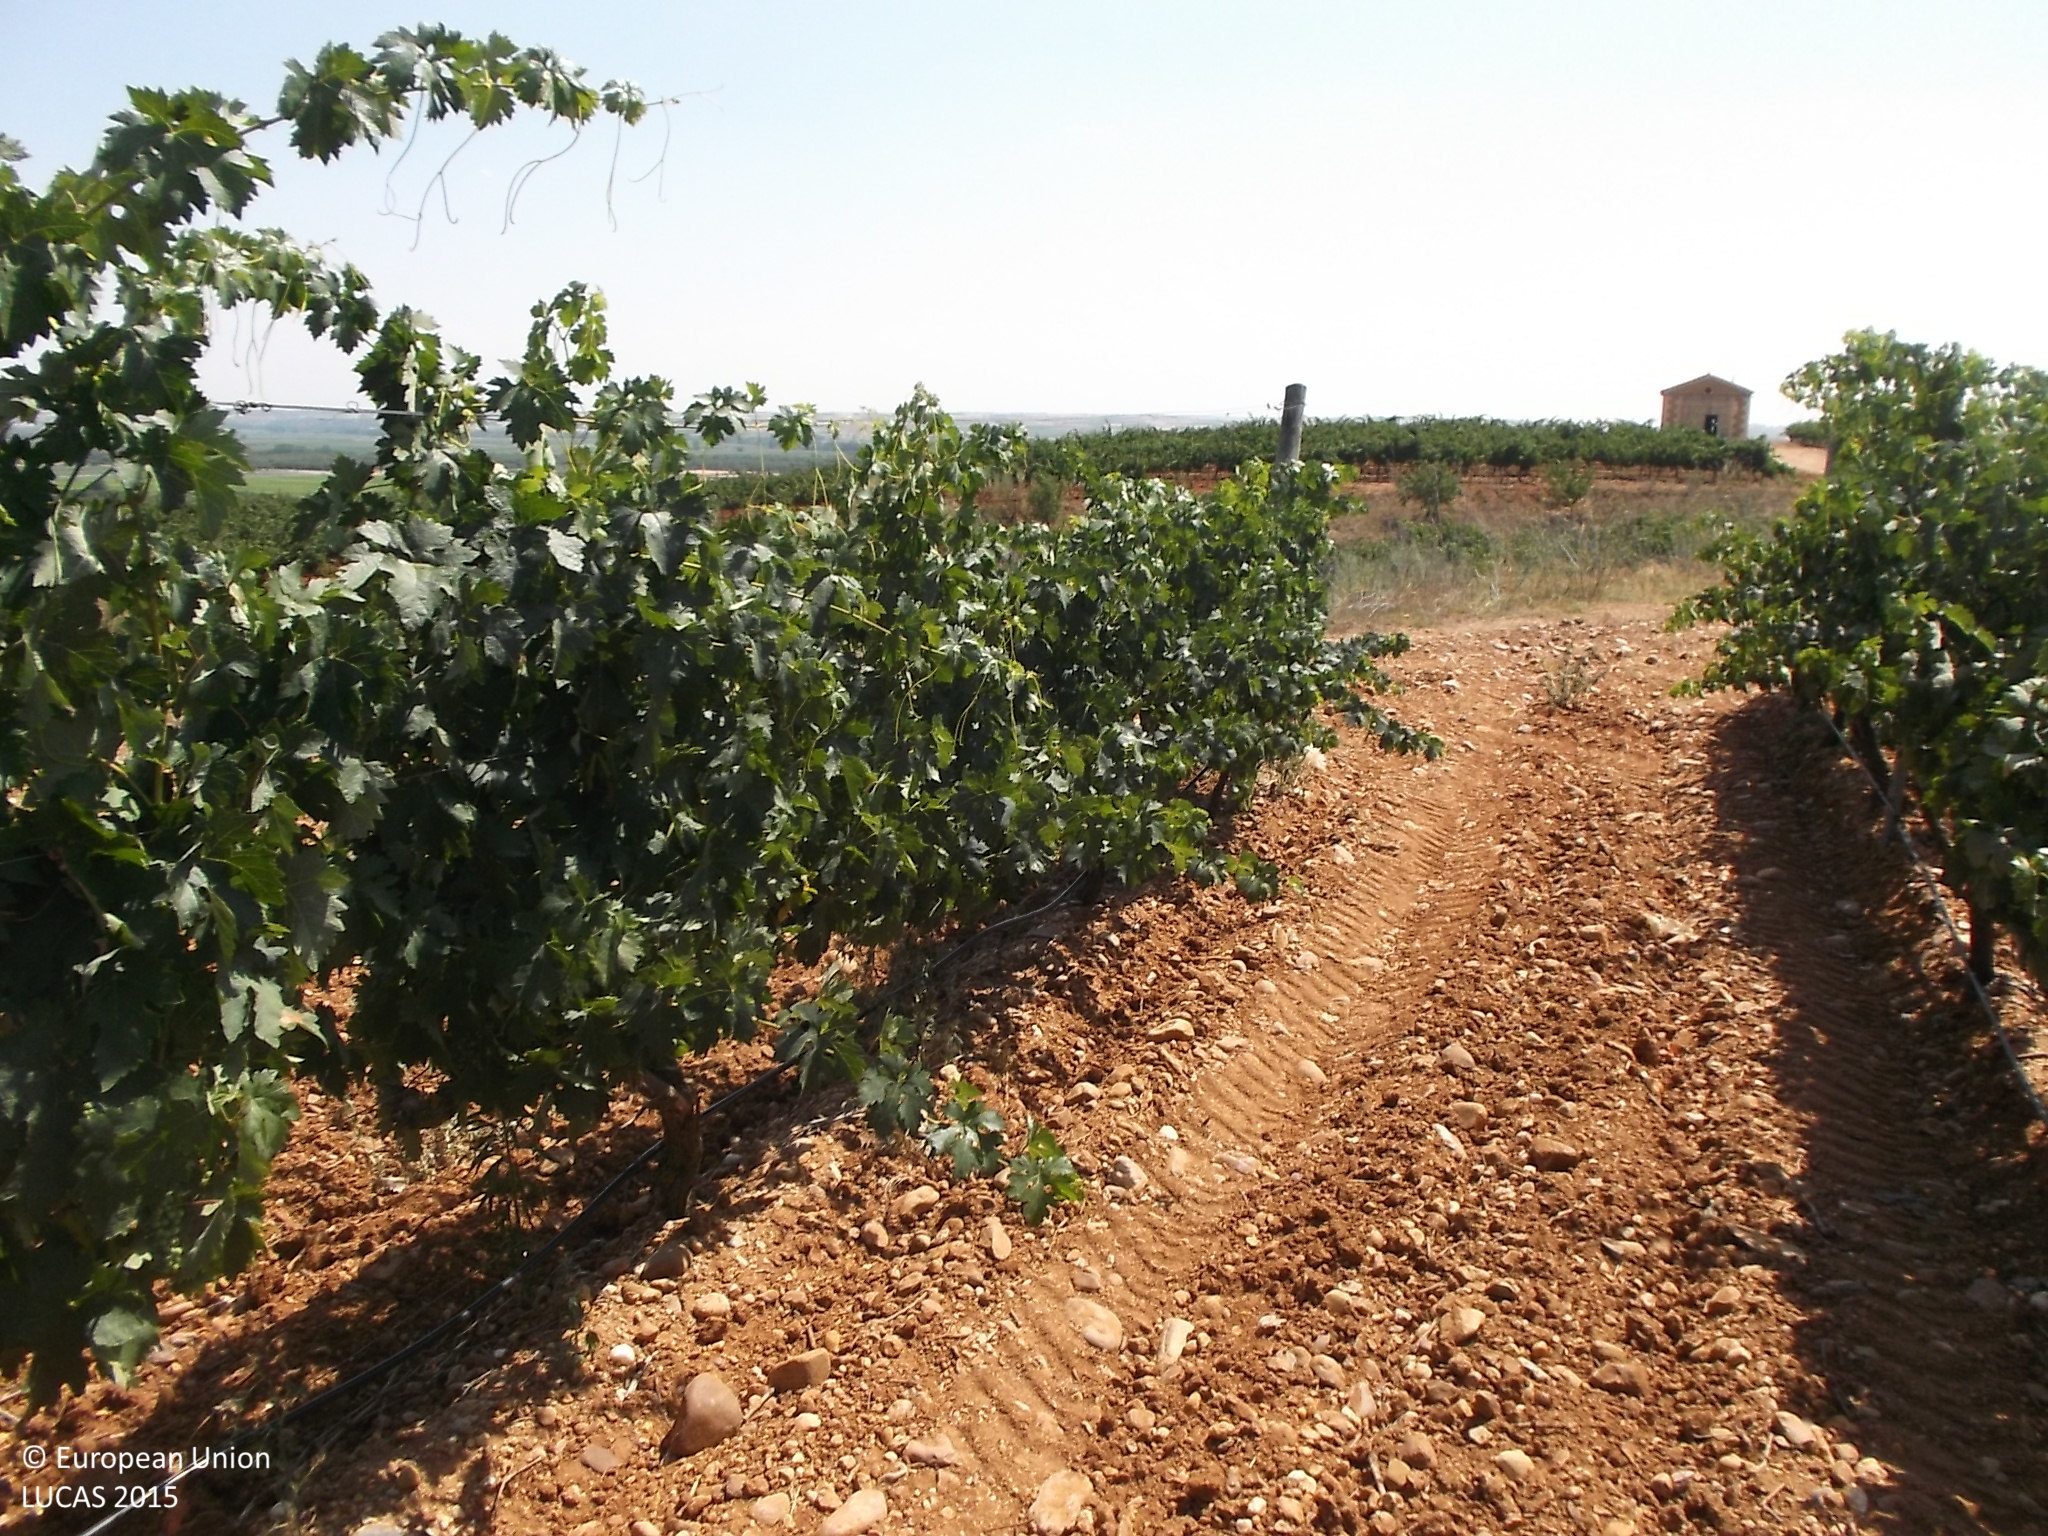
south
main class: Cropland
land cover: Vineyards
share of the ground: 10 - 25 %
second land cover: Other bare soil
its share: > 75 %
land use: Agriculture (excluding fallow land and kitchen gardens)
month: July
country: ES
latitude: 41.4837
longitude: -5.2995
